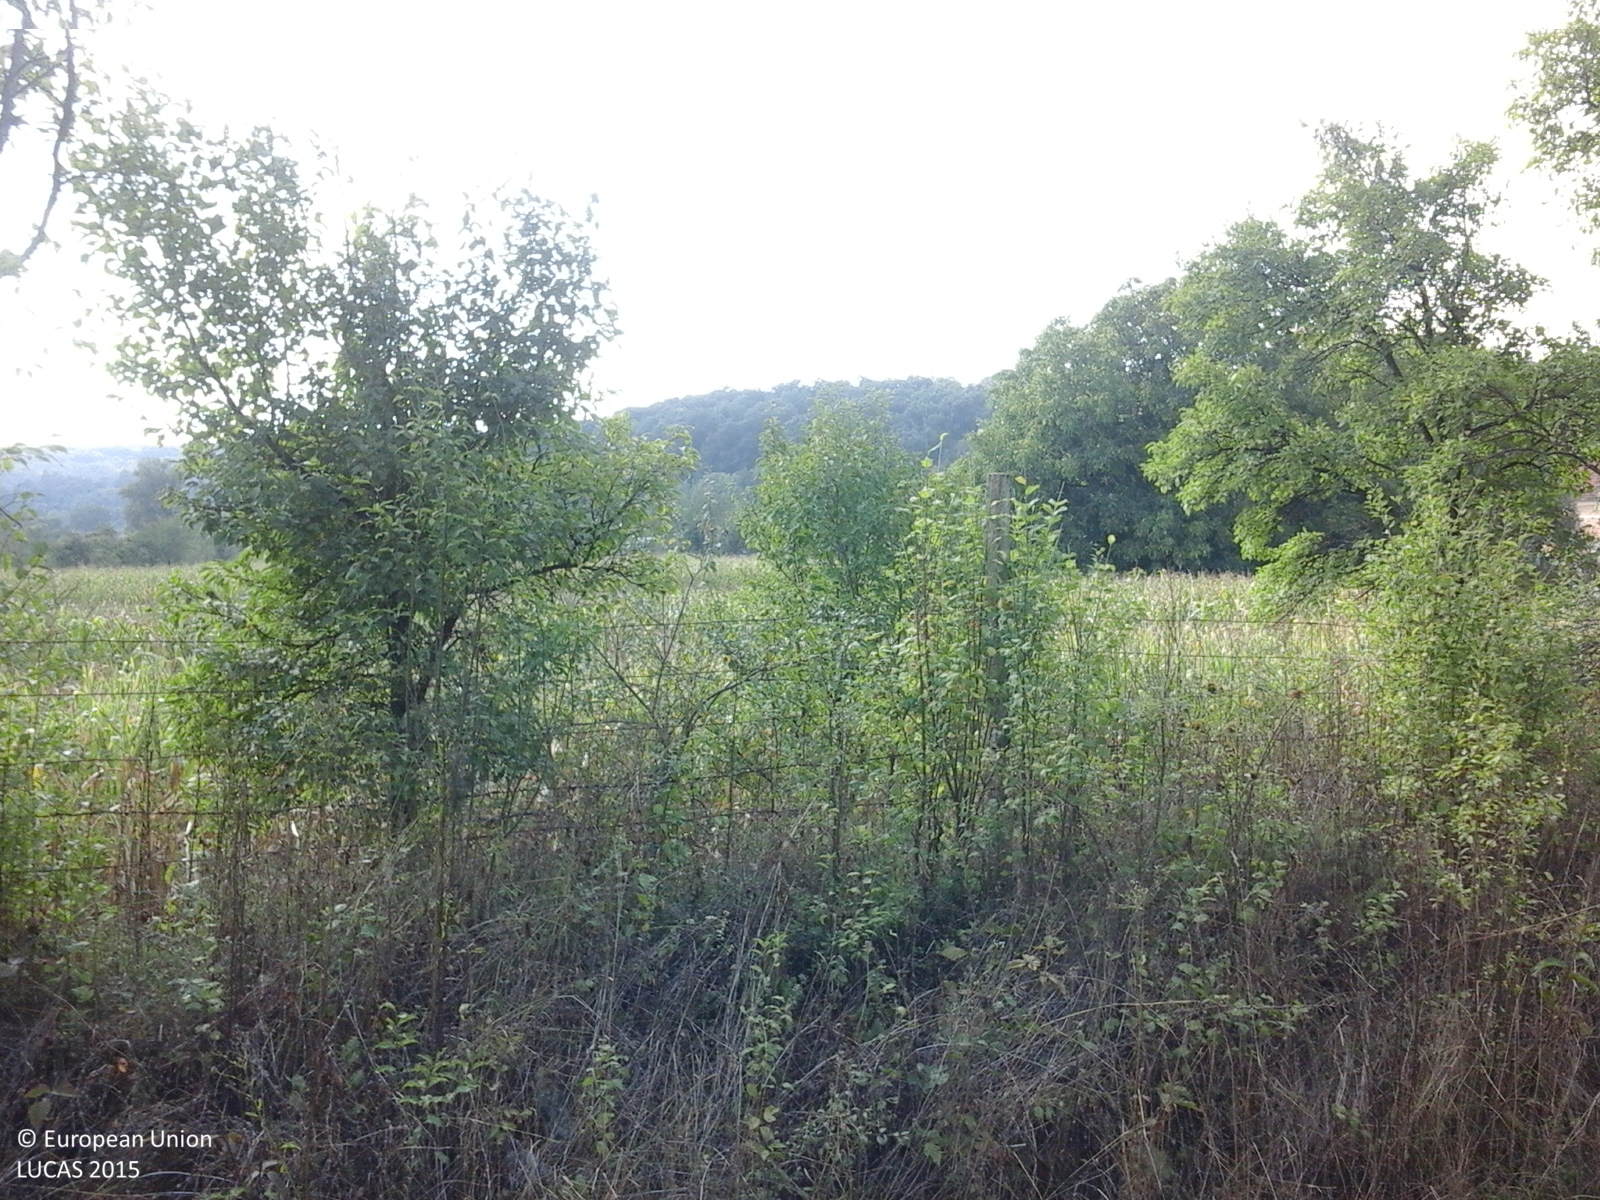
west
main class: Cropland
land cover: Maize
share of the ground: > 75 %
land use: Agriculture (excluding fallow land and kitchen gardens)
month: August
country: RO
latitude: 46.1110
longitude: 21.8267
